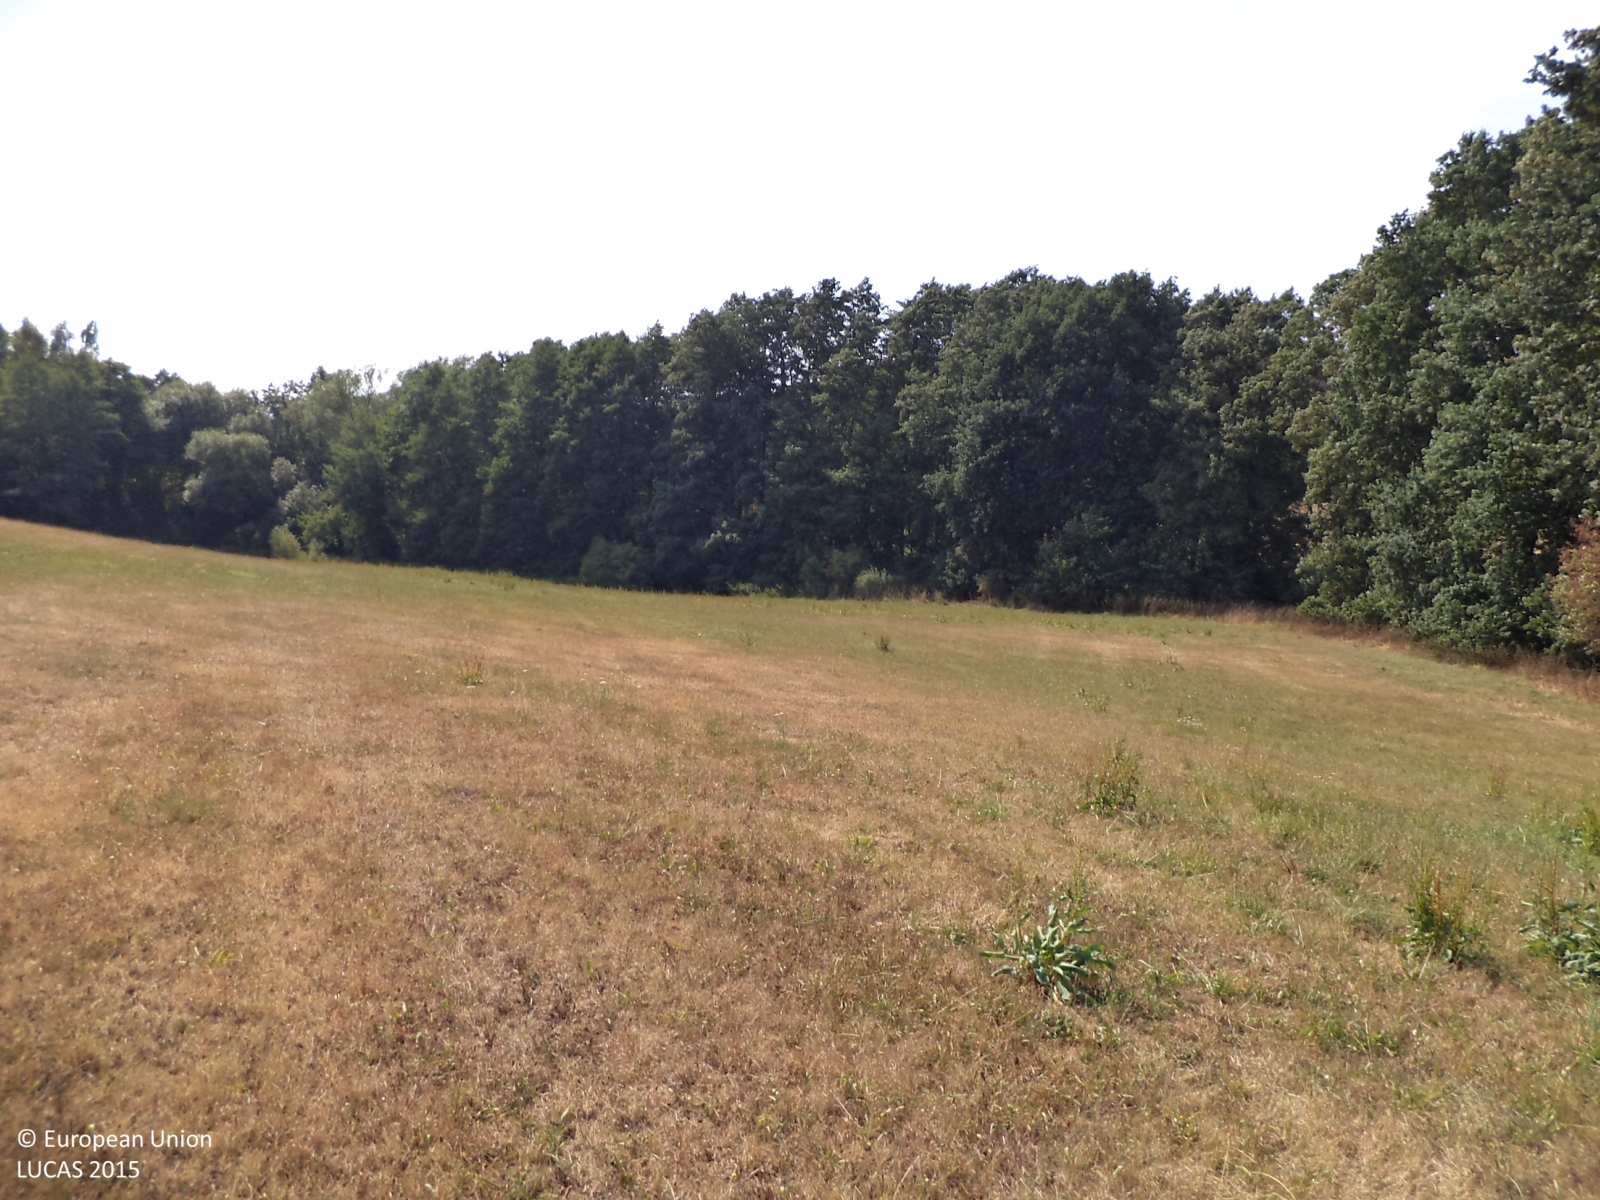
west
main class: Grassland
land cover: Grassland without tree/shrub cover
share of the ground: > 75 %
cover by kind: herbaceous plants 100 %
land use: Agriculture (excluding fallow land and kitchen gardens)
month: August
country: CZ
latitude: 49.6282
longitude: 14.4732
